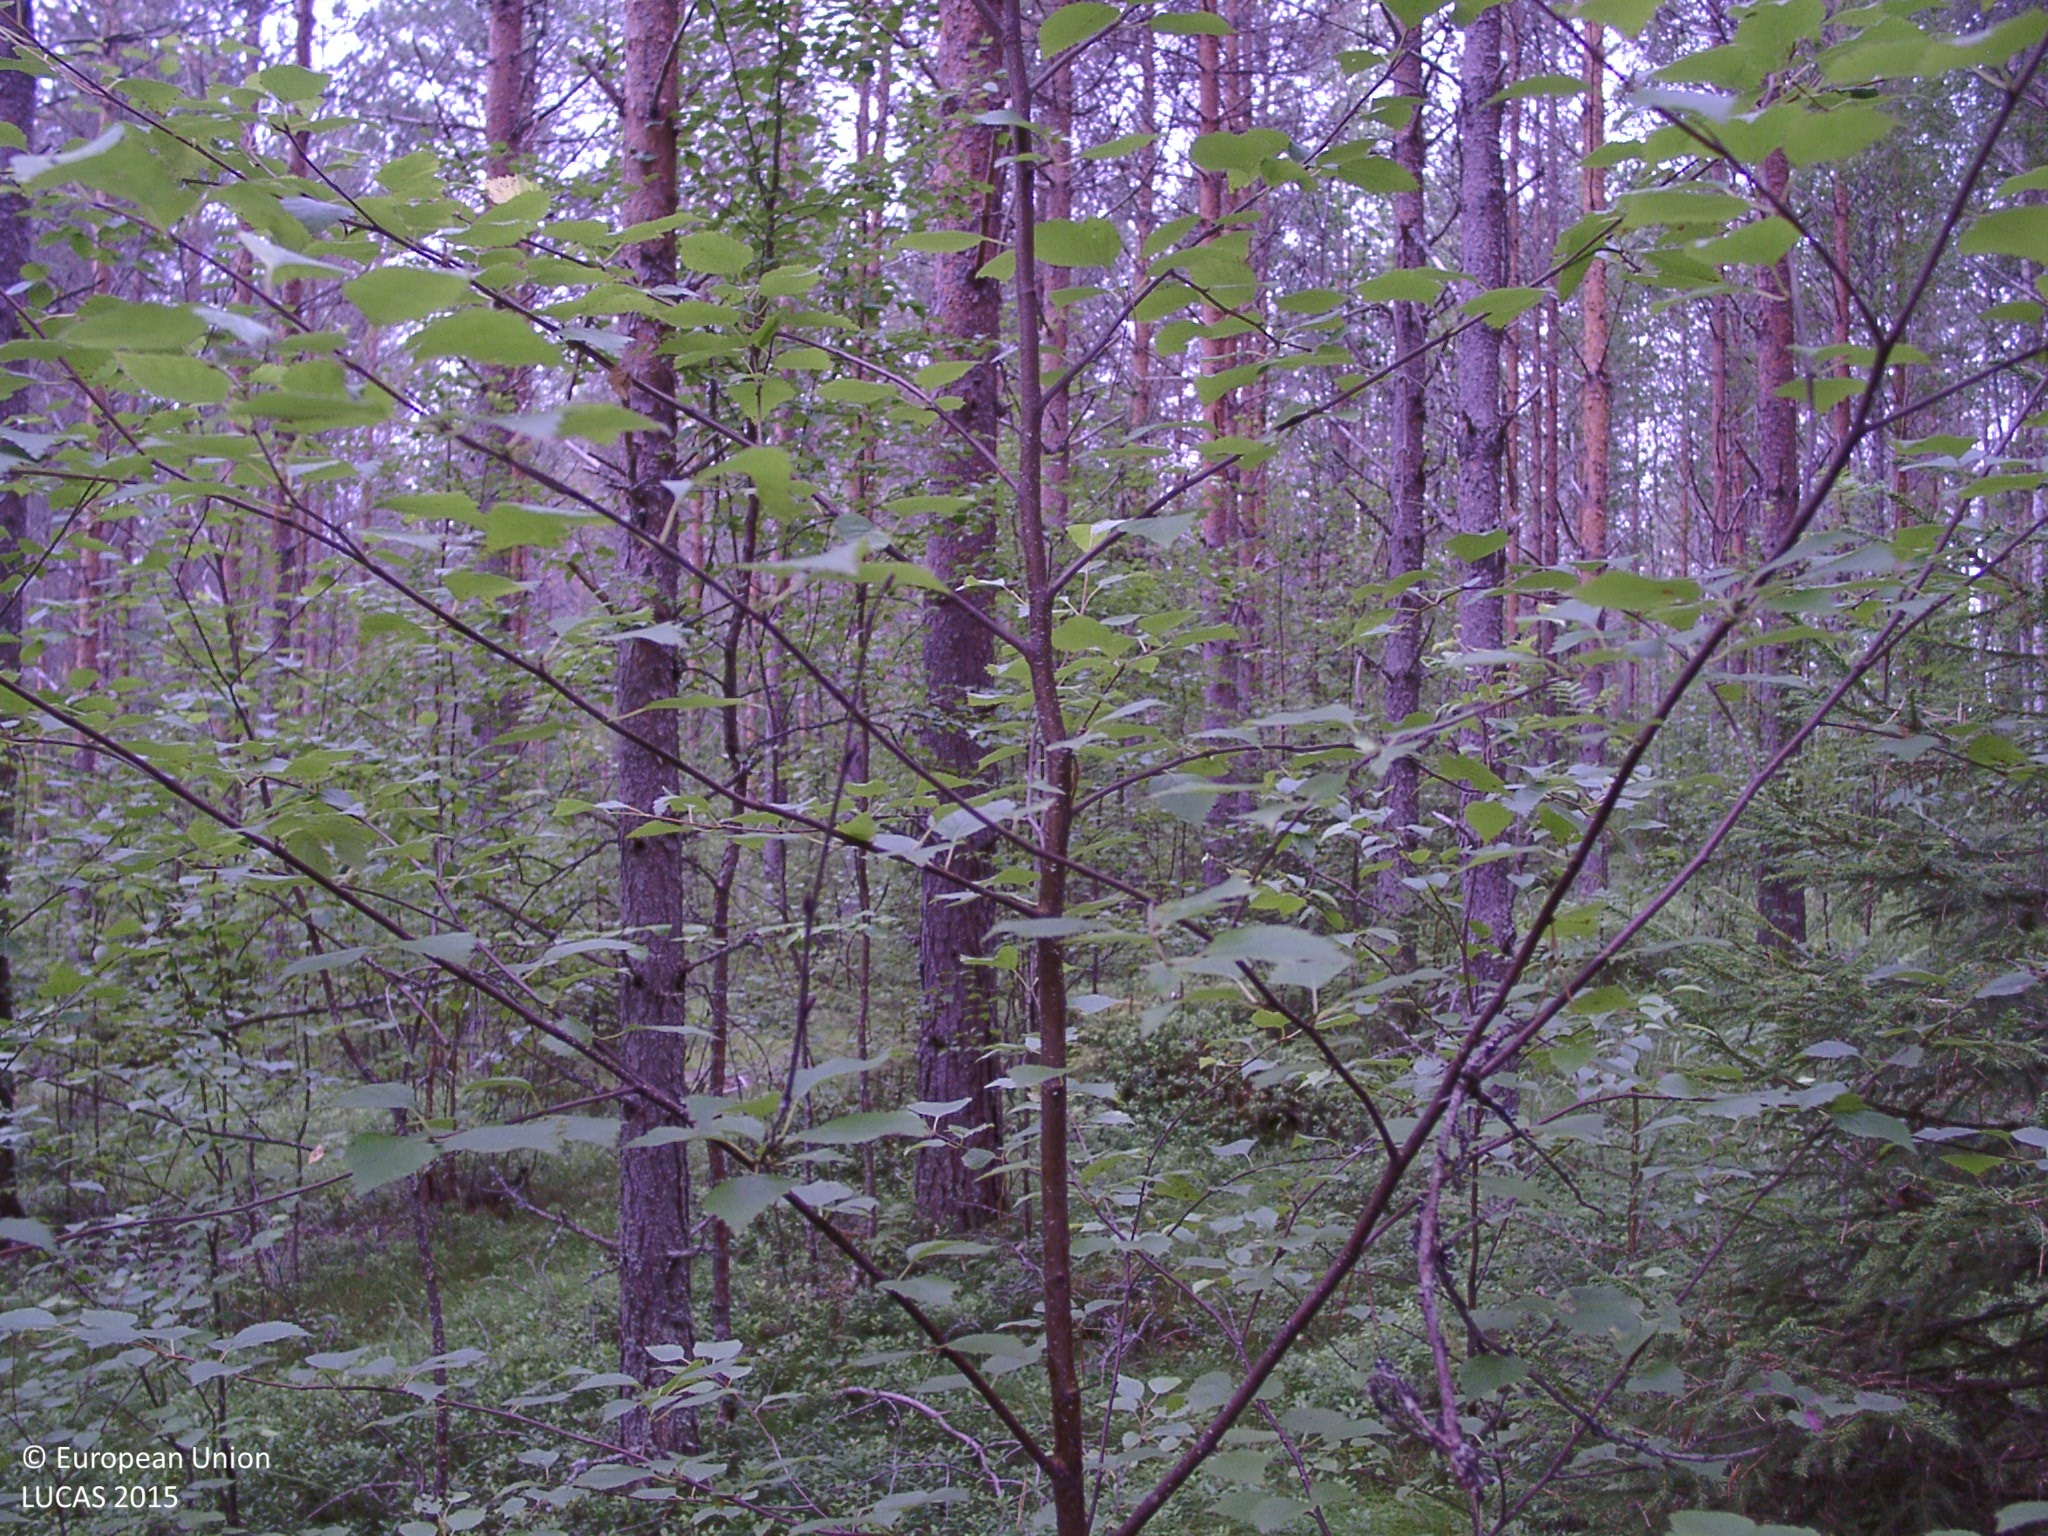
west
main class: Woodland
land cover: Other mixed woodland
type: boreal forest
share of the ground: > 75 %
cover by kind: coniferous forest trees 60 %, broadleaved forest trees 20 %, shrubs 10 %, herbaceous plants 5 %, lichens and mosses 5 %
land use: Forestry
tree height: > 5 m
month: July
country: FI
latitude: 62.2652
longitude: 25.3067
